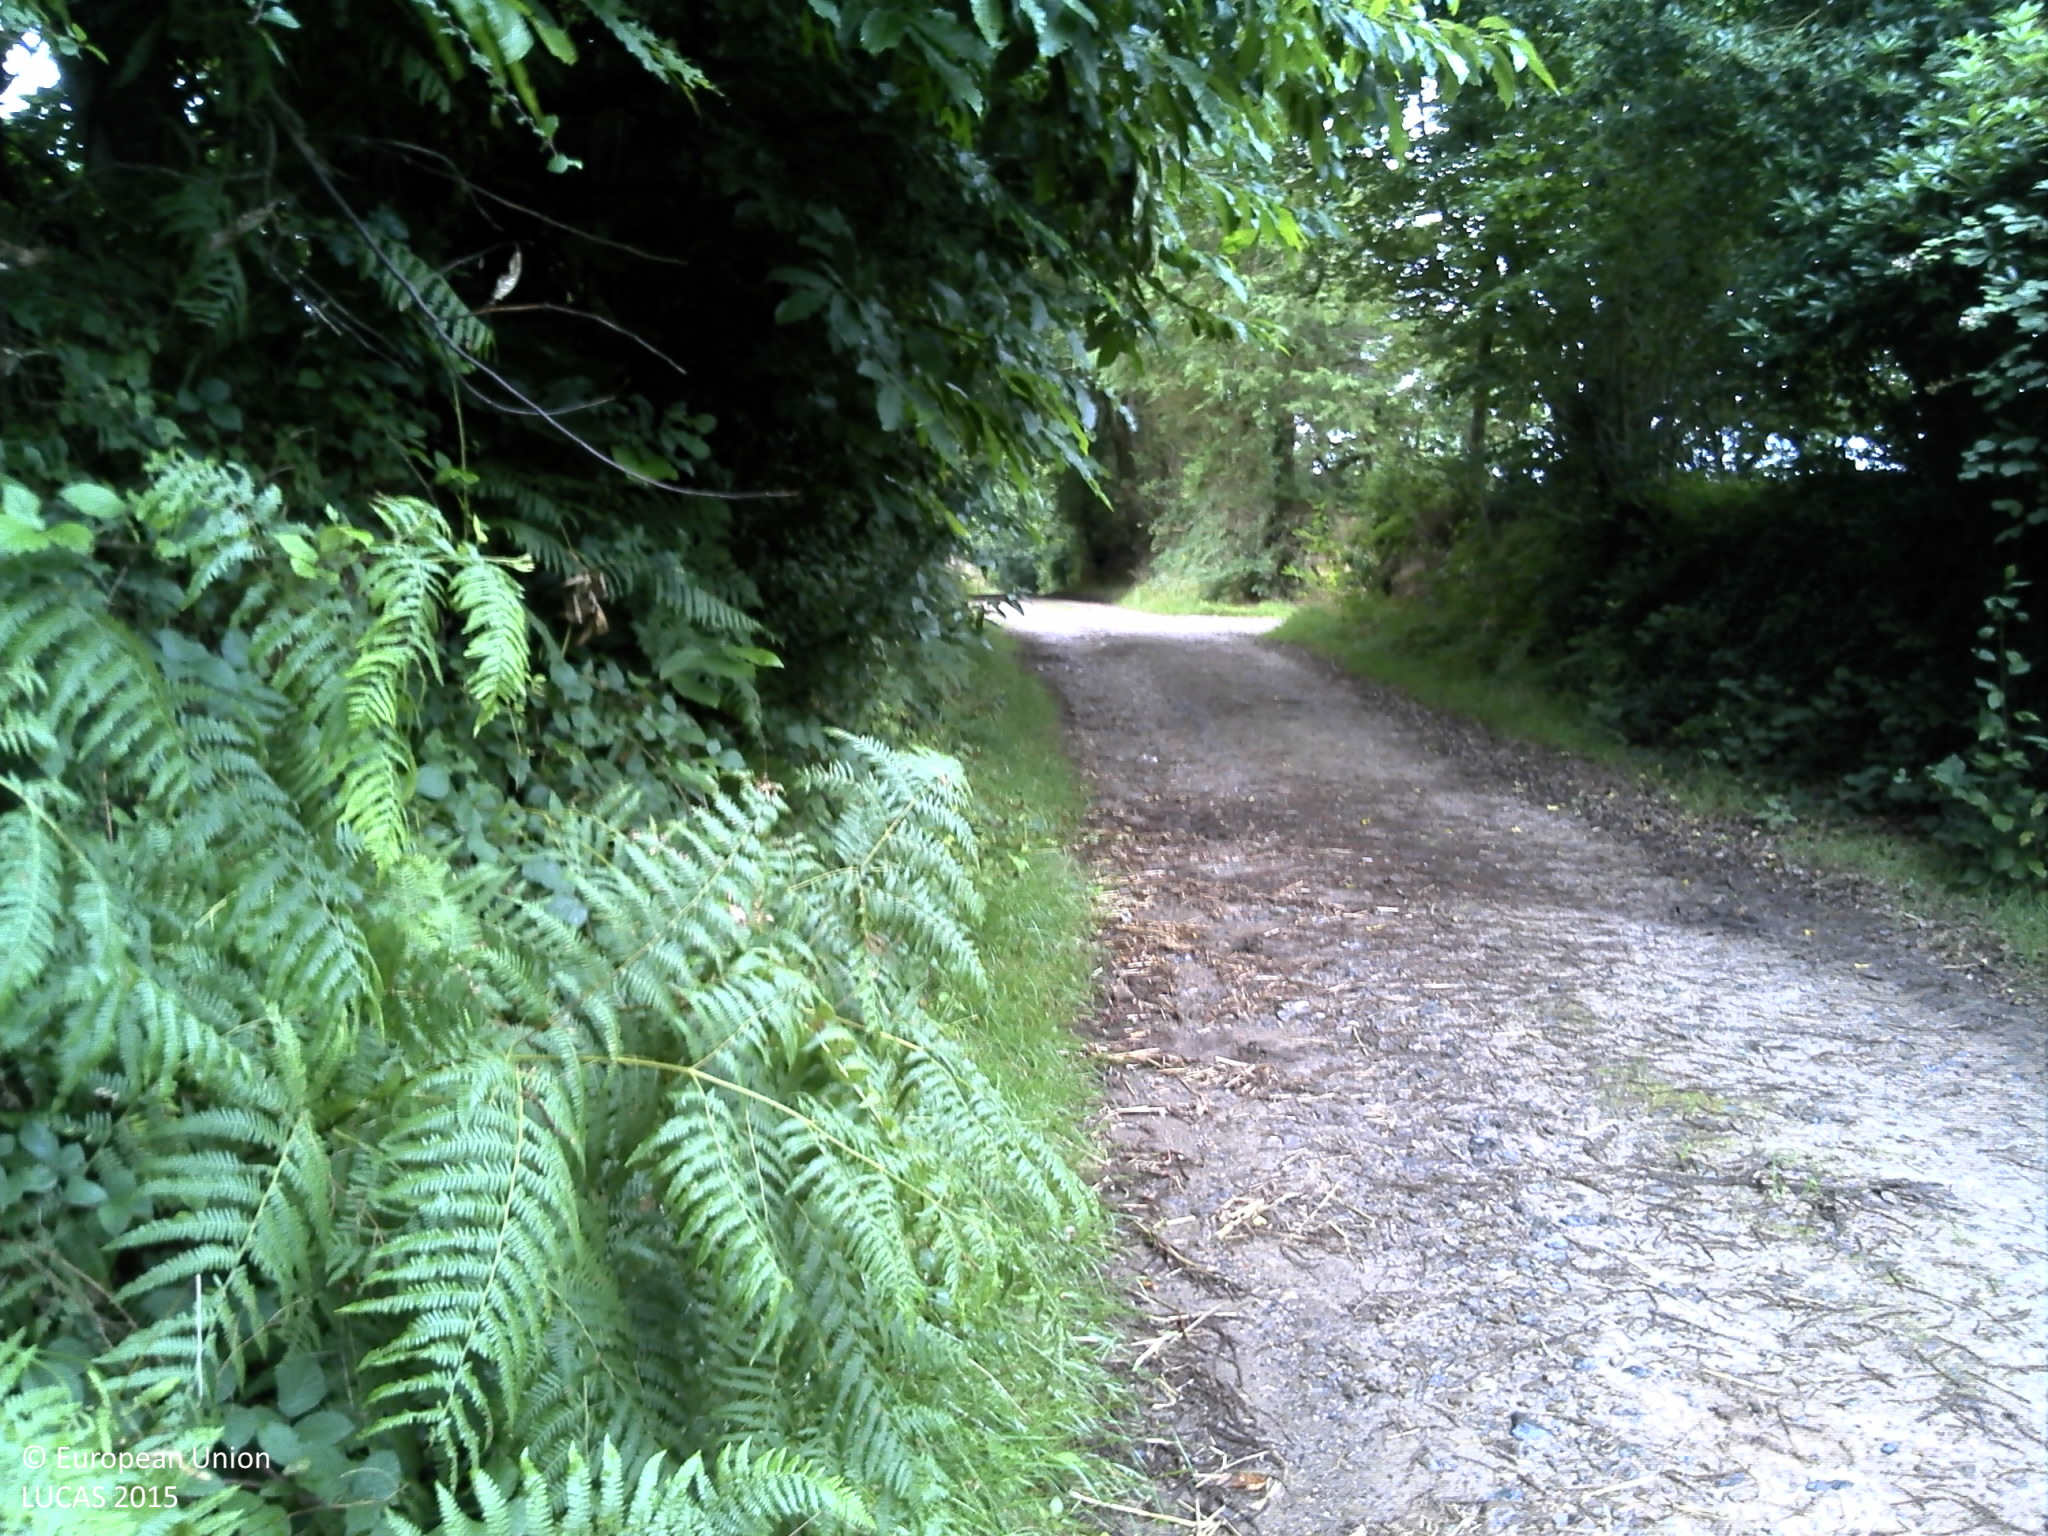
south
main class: Woodland
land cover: Broadleaved woodland
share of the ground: > 75 %
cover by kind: broadleaved forest trees 100 %
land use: Semi-natural and natural areas not in use
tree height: > 5 m
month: July
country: FR
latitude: 48.3903
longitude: -4.2322
